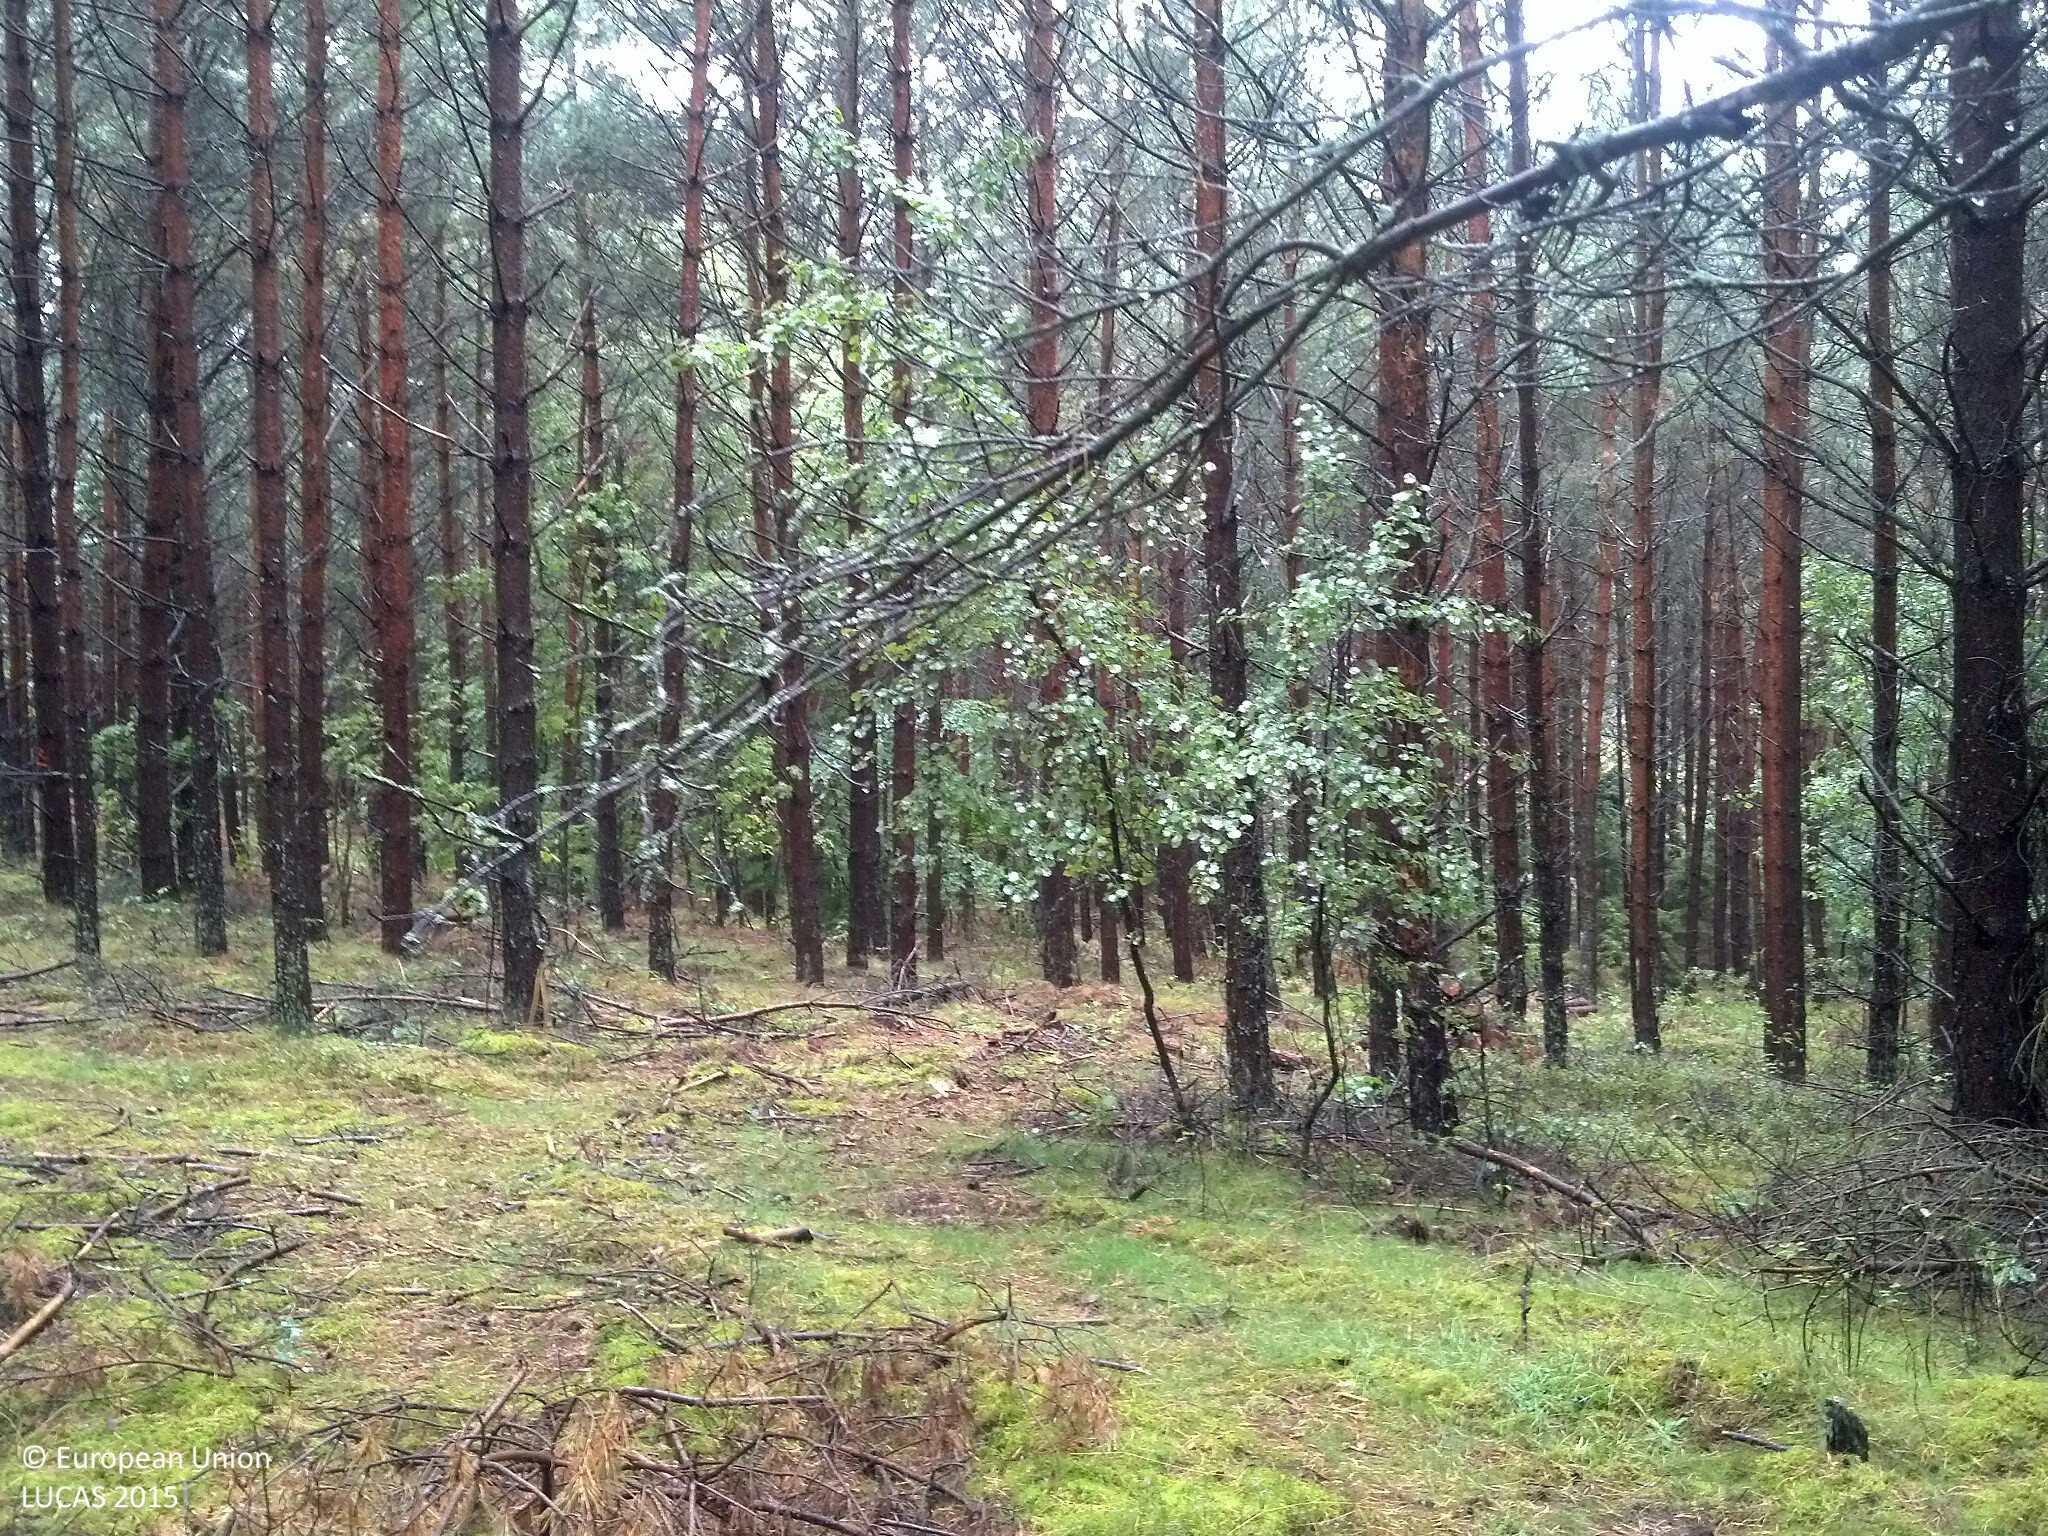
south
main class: Woodland
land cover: Pine dominated coniferous woodland
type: hemiboreal forest and nemoral coniferous forest and mixed broadleaved-coniferous forest
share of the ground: > 75 %
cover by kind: coniferous forest trees 85 %, broadleaved forest trees 5 %, herbaceous plants 5 %, lichens and mosses 5 %
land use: Forestry
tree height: > 5 m
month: September
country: PL
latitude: 54.5341
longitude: 17.9099
